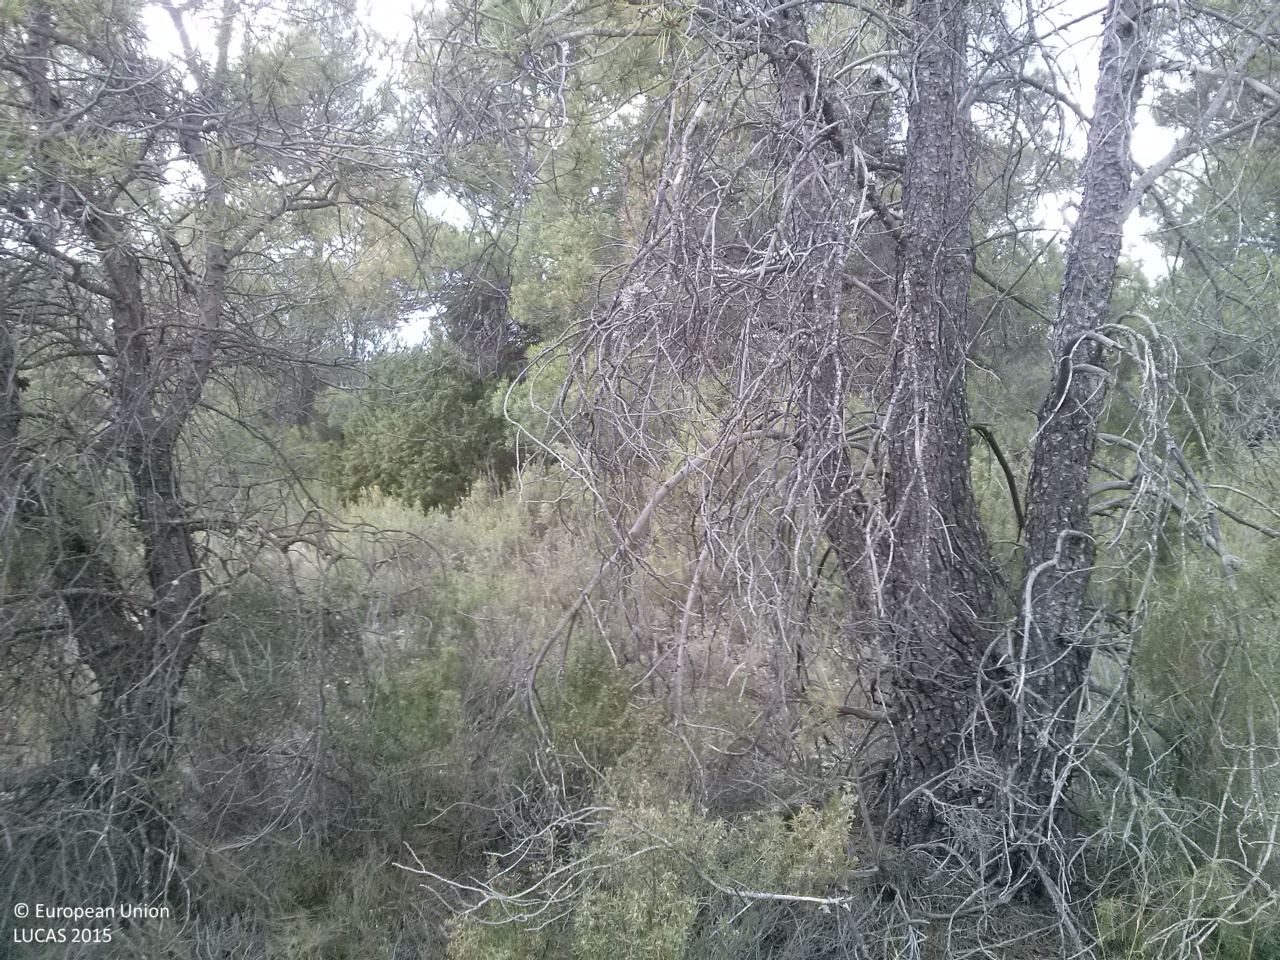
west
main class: Woodland
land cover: Pine dominated coniferous woodland
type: coniferous forest of the mediterranean region
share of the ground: 10 - 25 %
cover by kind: shrubs 50 %, coniferous forest trees 25 %, herbaceous plants 25 %
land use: Forestry
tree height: > 5 m
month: June
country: ES
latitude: 39.7580
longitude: -1.7629
